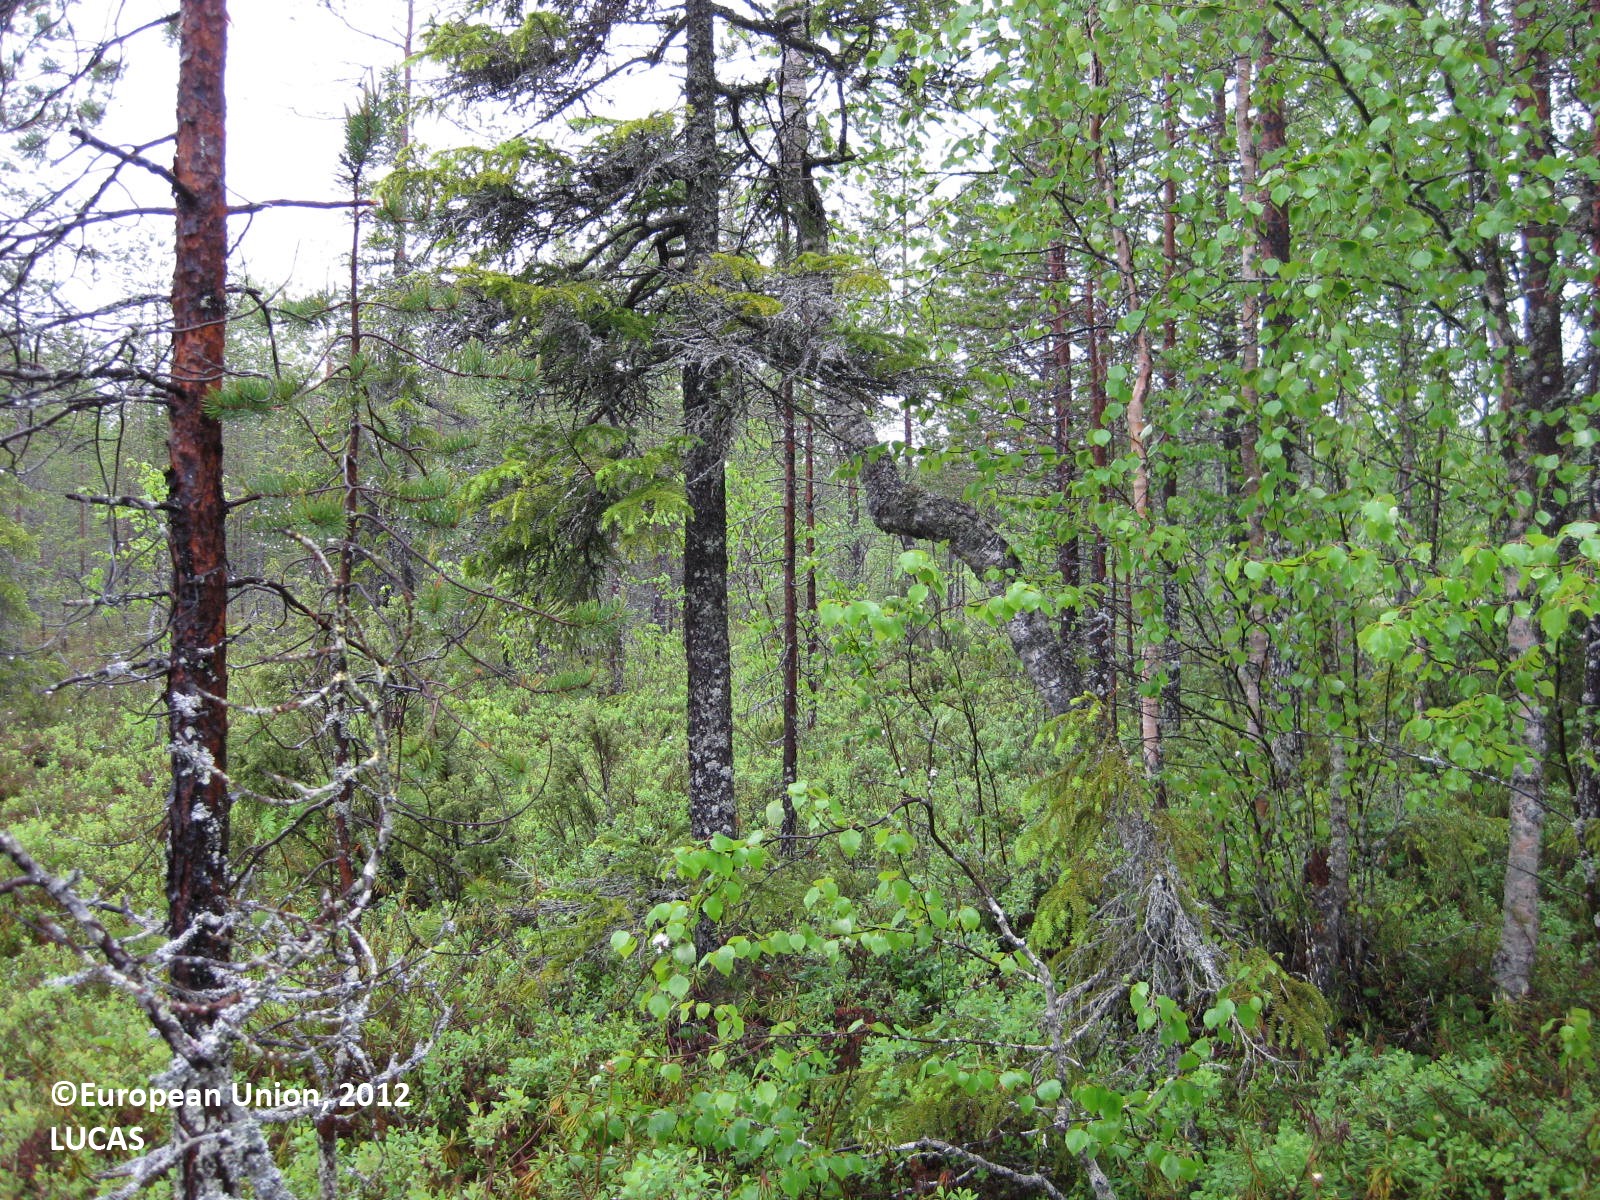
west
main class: Woodland
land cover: Pine dominated mixed woodland
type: boreal forest
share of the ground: 50 - 75 %
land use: Forestry
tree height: > 5 m
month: June
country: FI
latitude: 65.2758
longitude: 28.9740
